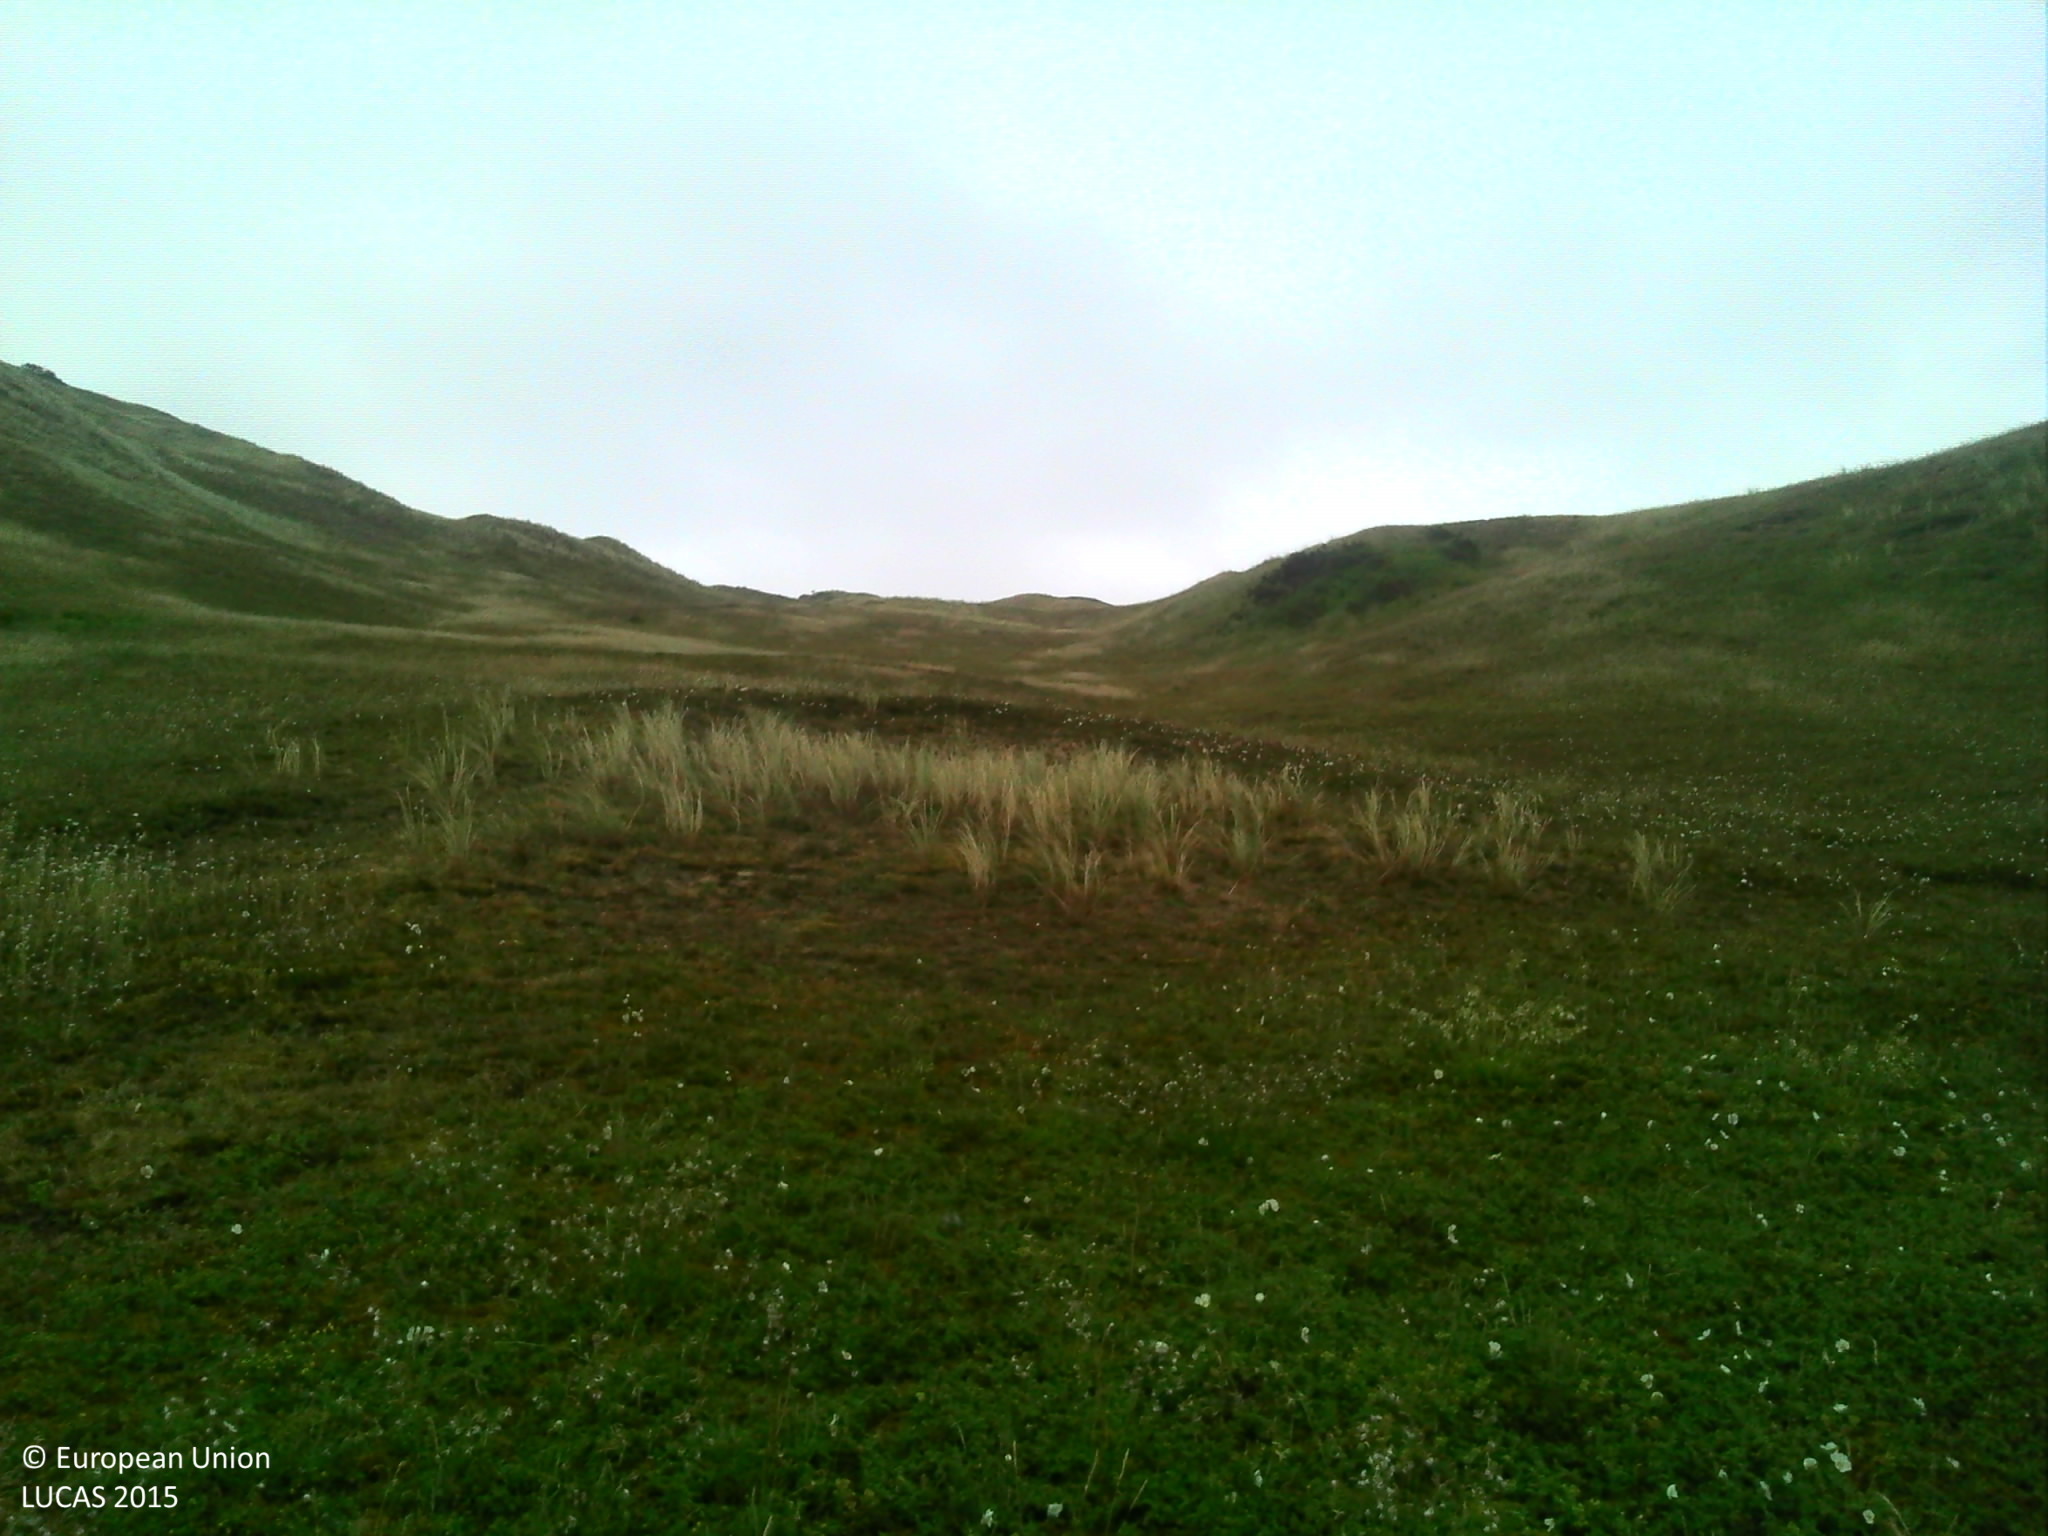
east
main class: Grassland
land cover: Spontaneously vegetated surfaces
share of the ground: > 75 %
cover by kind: herbaceous plants 100 %
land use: Semi-natural and natural areas not in use
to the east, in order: Spontaneously vegetated surfaces
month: June
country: FR
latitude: 49.6022
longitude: -1.8295
